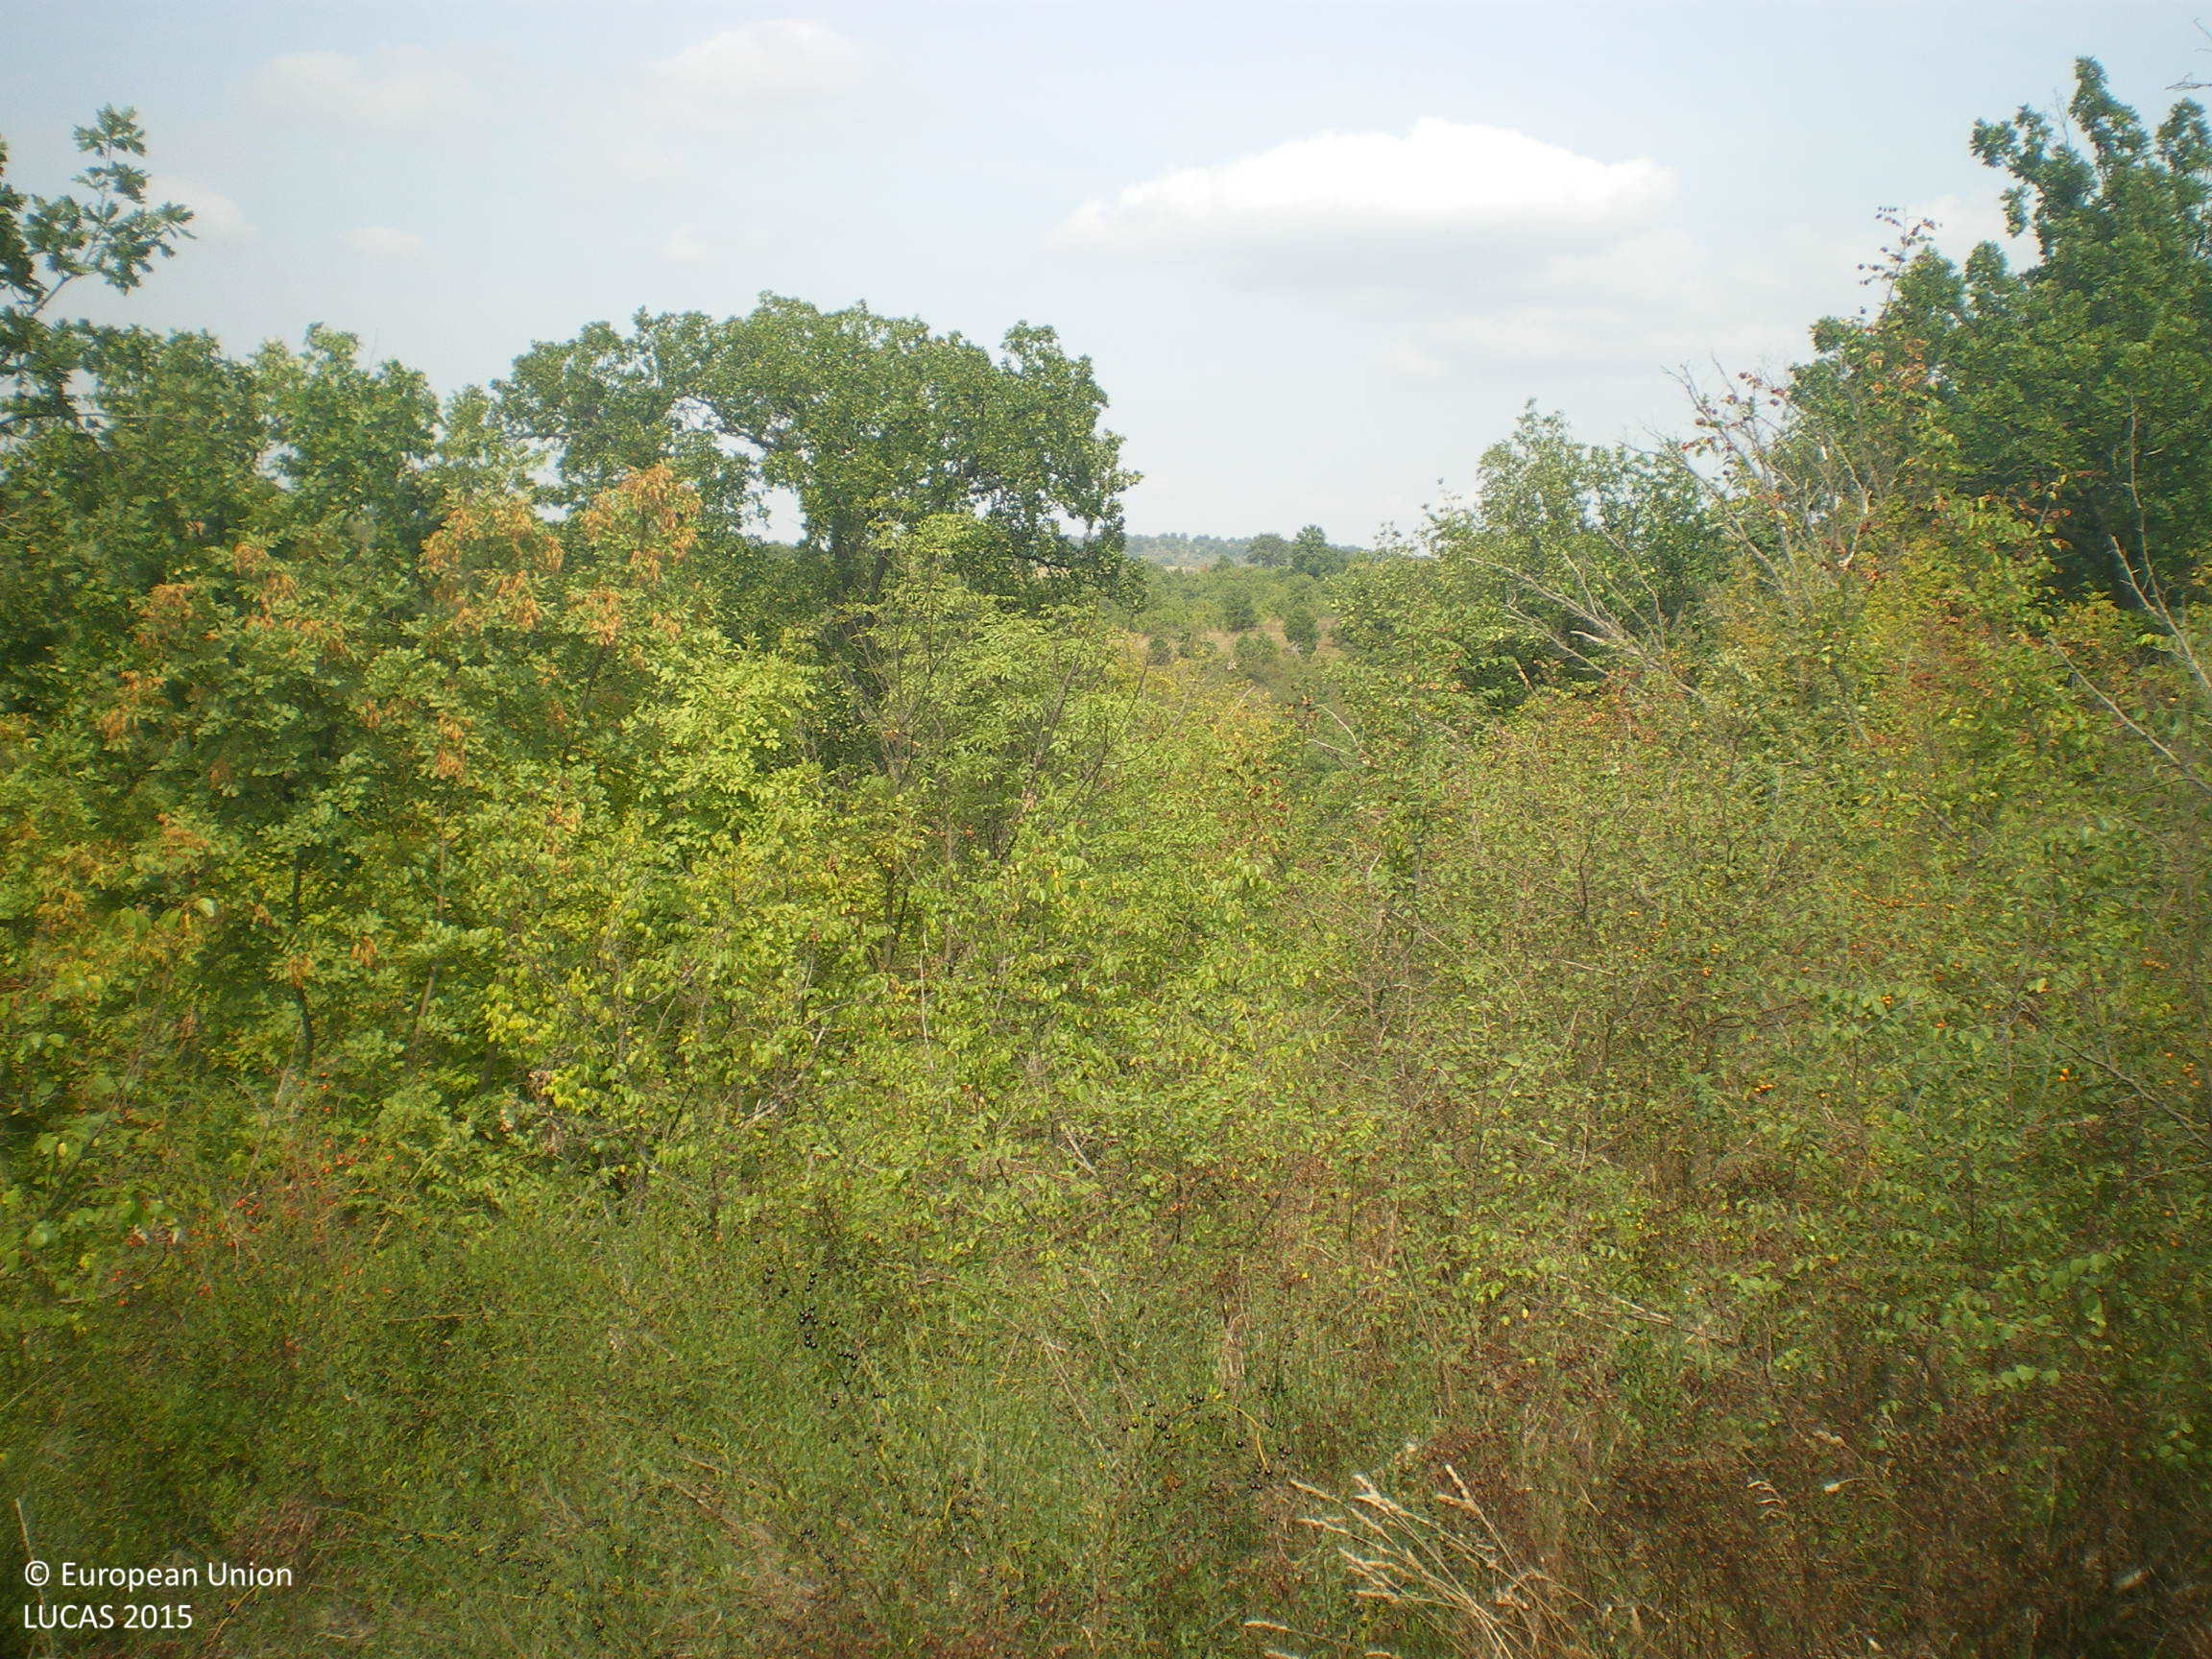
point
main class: Woodland
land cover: Broadleaved woodland
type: mesophytic deciduous forest
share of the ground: > 75 %
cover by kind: broadleaved forest trees 70 %, shrubs 20 %, herbaceous plants 10 %
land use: Semi-natural and natural areas not in use
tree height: > 5 m
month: September
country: BG
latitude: 41.8605
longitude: 25.9365
